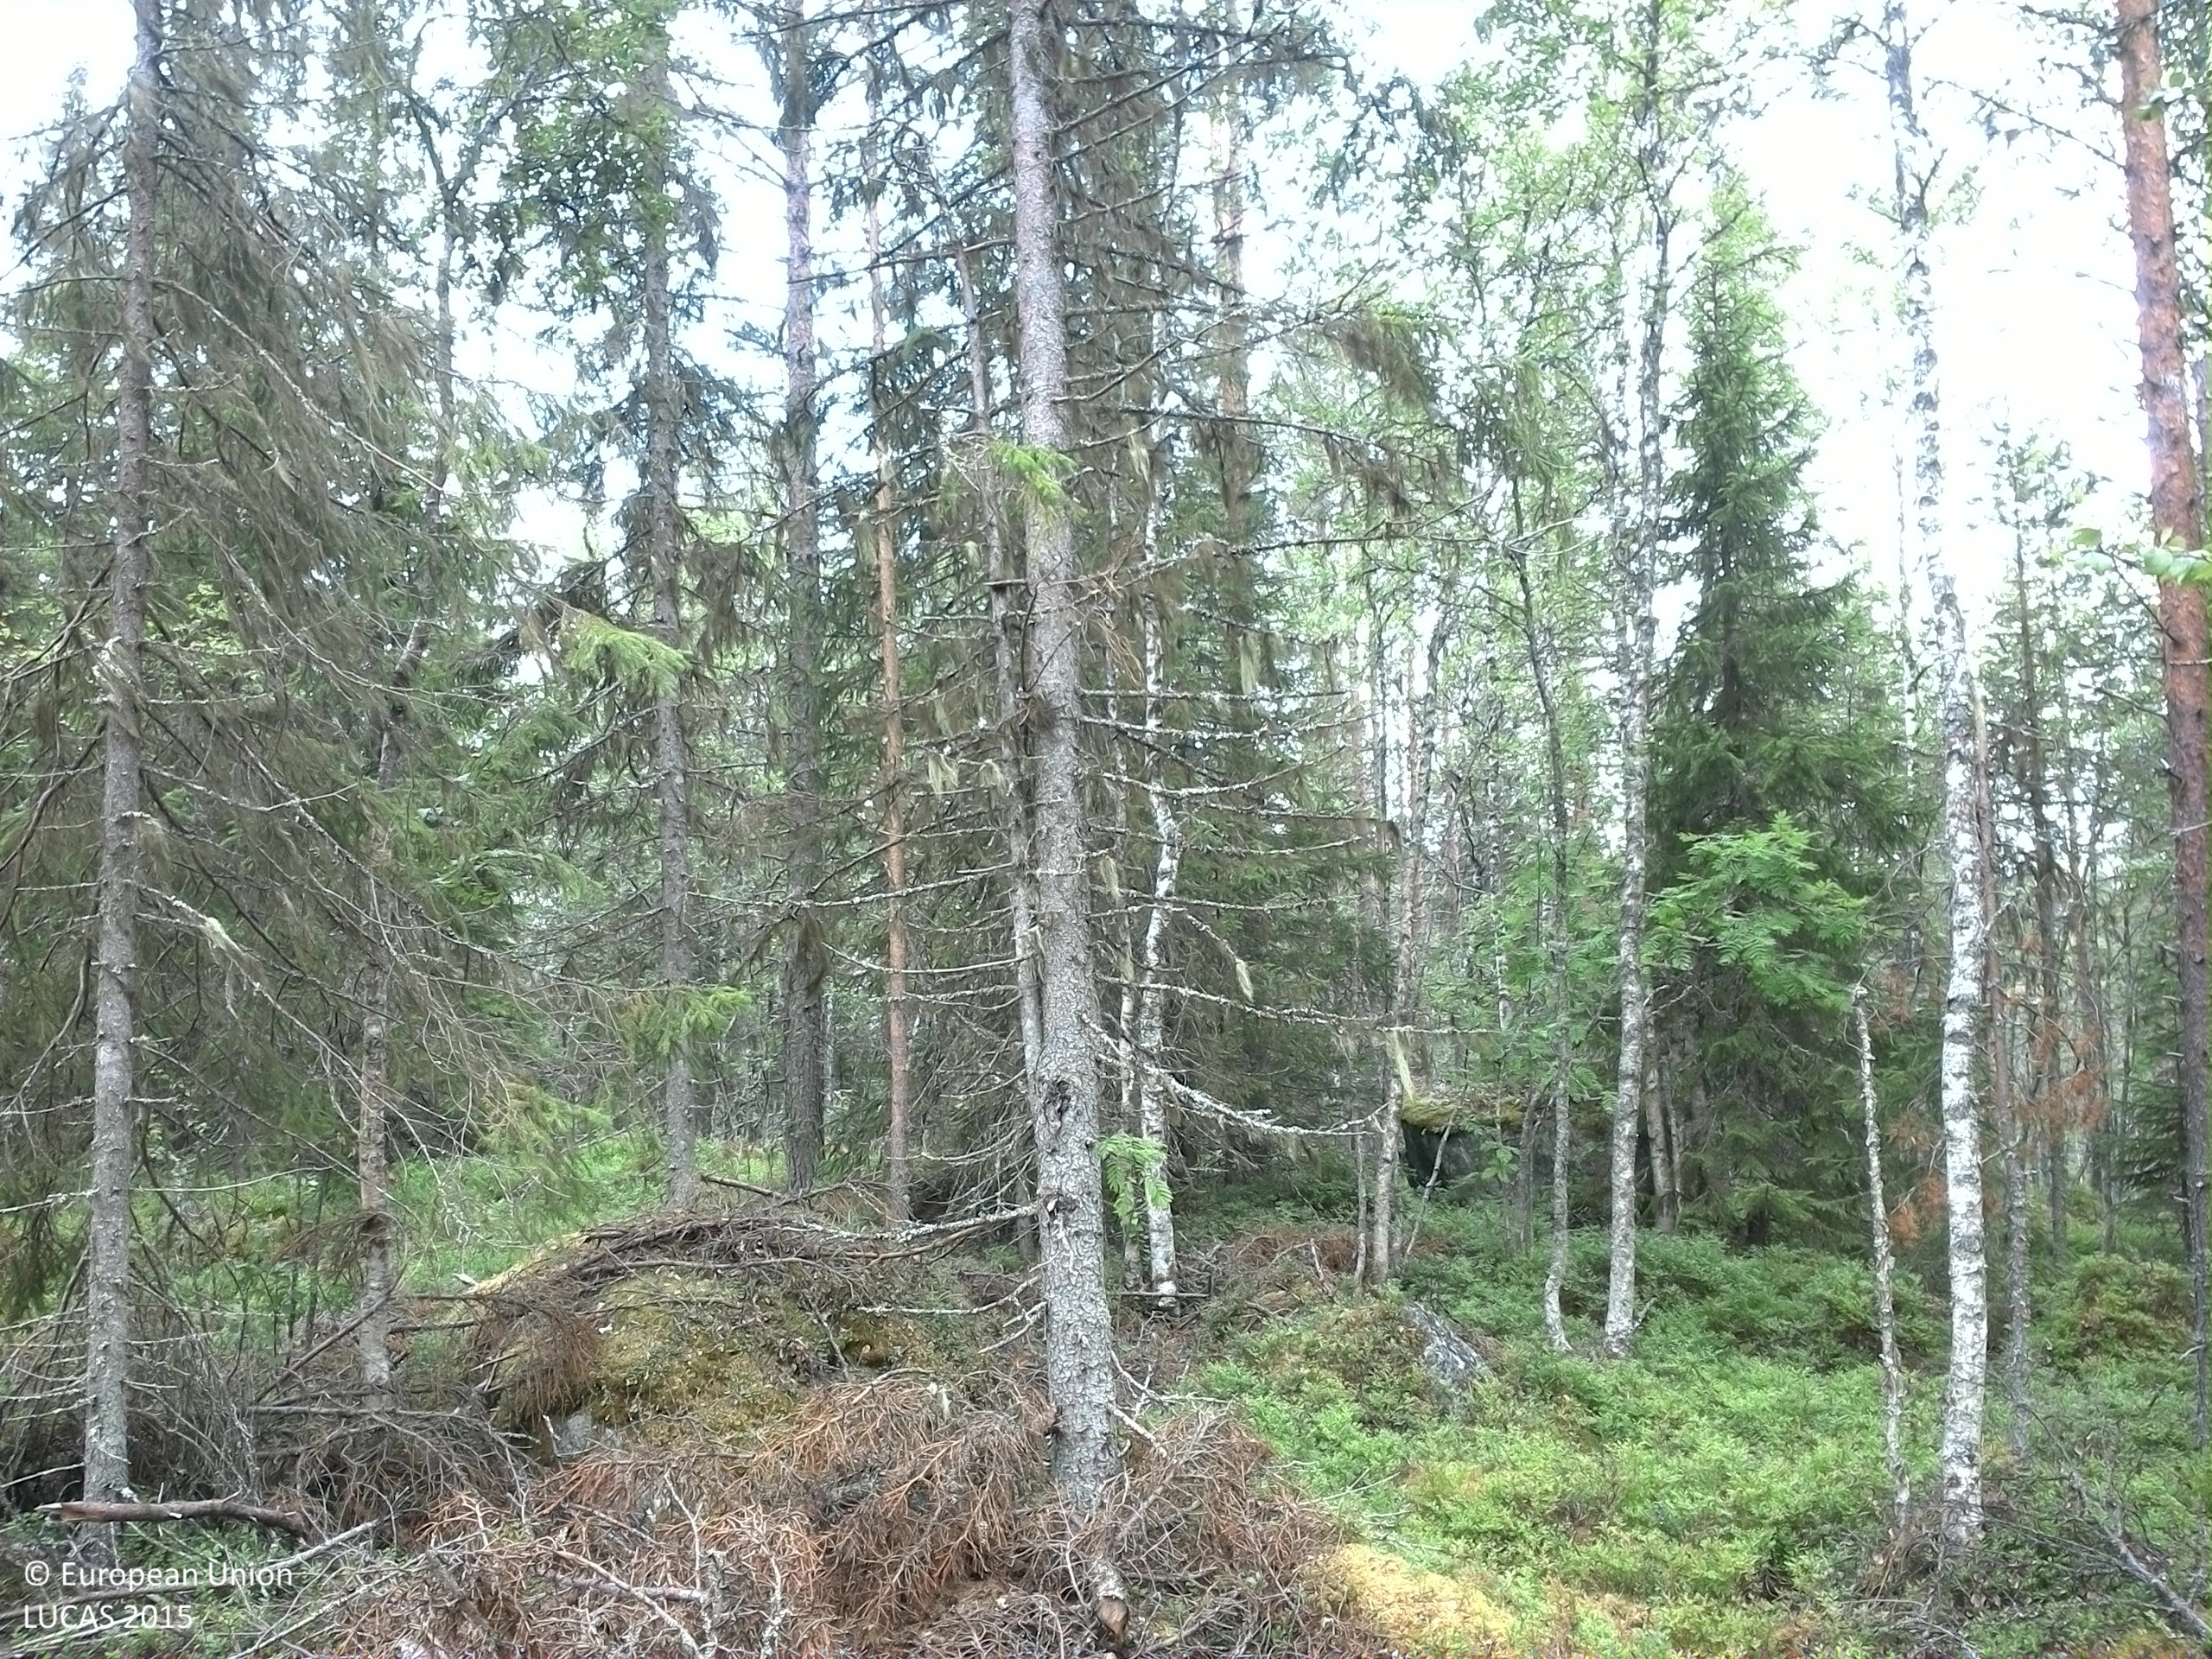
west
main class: Woodland
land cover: Spruce dominated coniferous woodland
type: boreal forest
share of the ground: 50 - 75 %
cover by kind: coniferous forest trees 60 %, broadleaved forest trees 15 %, shrubs 10 %, lichens and mosses 5 %
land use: Forestry
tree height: > 5 m
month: August
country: SE
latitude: 63.9087
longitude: 17.9401
